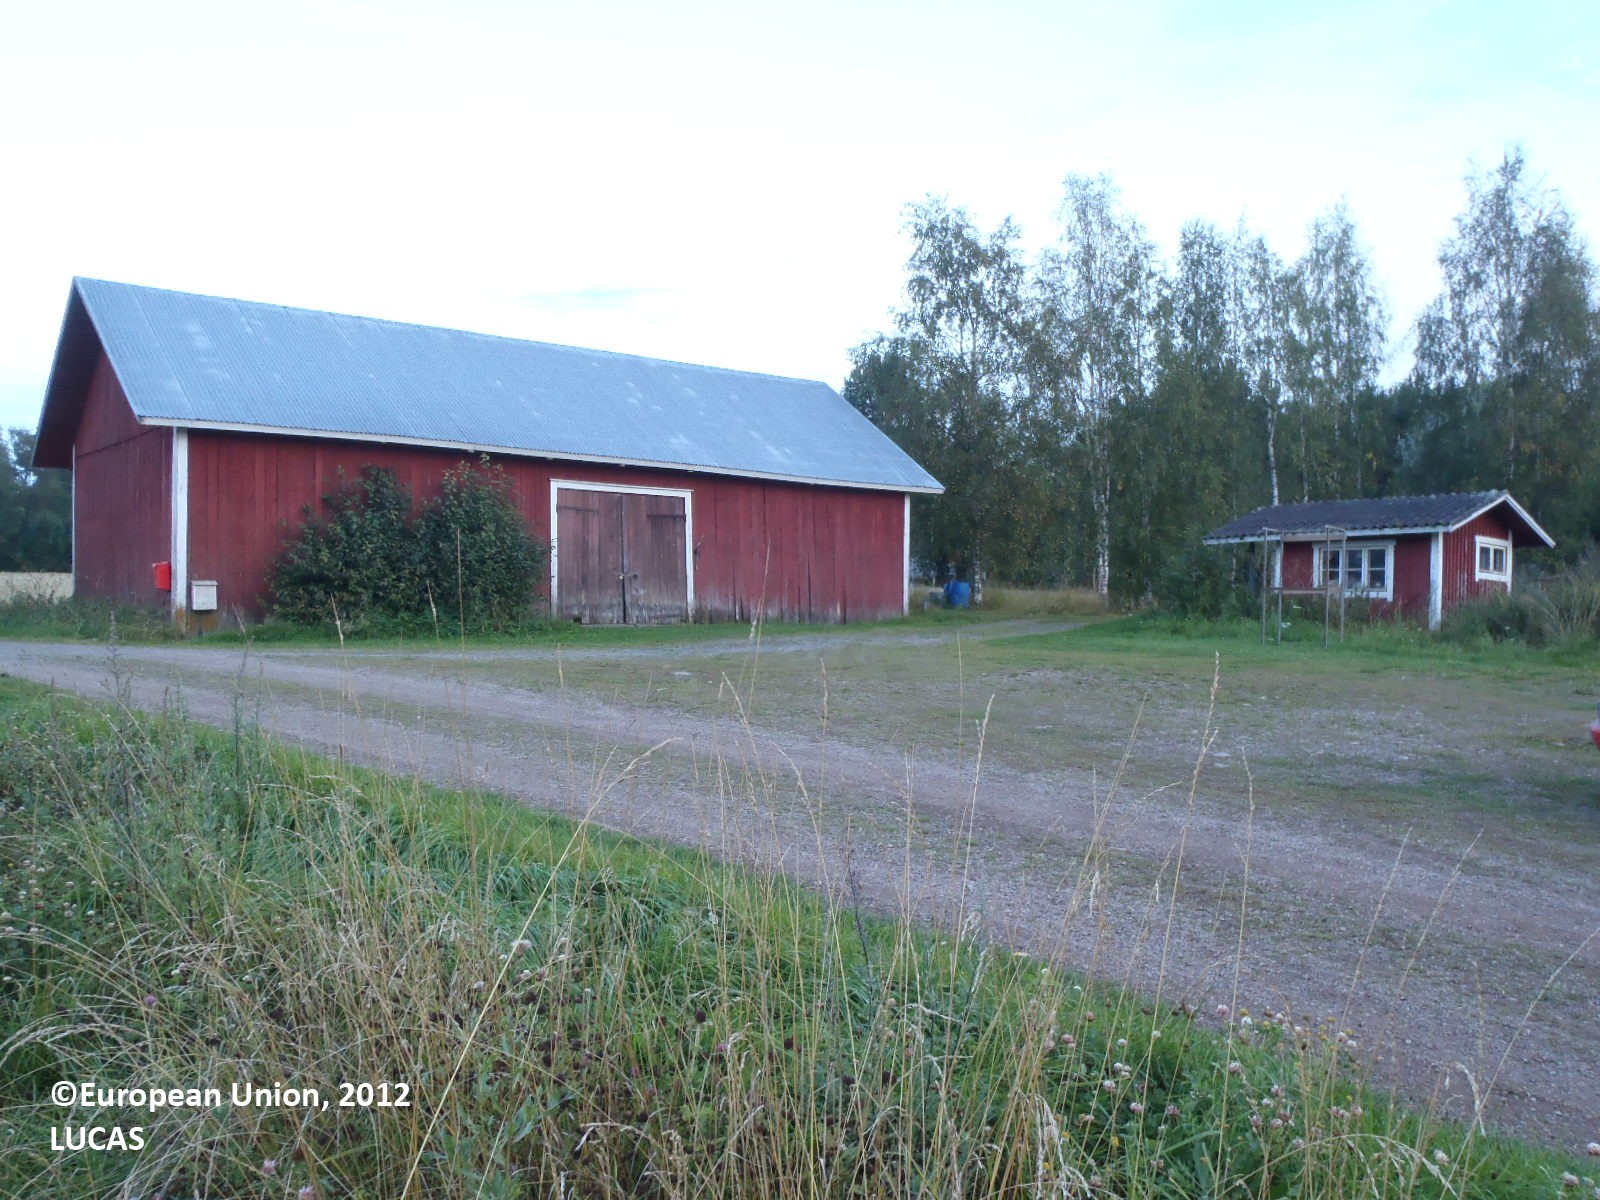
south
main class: Cropland
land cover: Barley
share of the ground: > 75 %
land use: Agriculture (excluding fallow land and kitchen gardens)
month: August
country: FI
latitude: 60.7039
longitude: 22.0256
